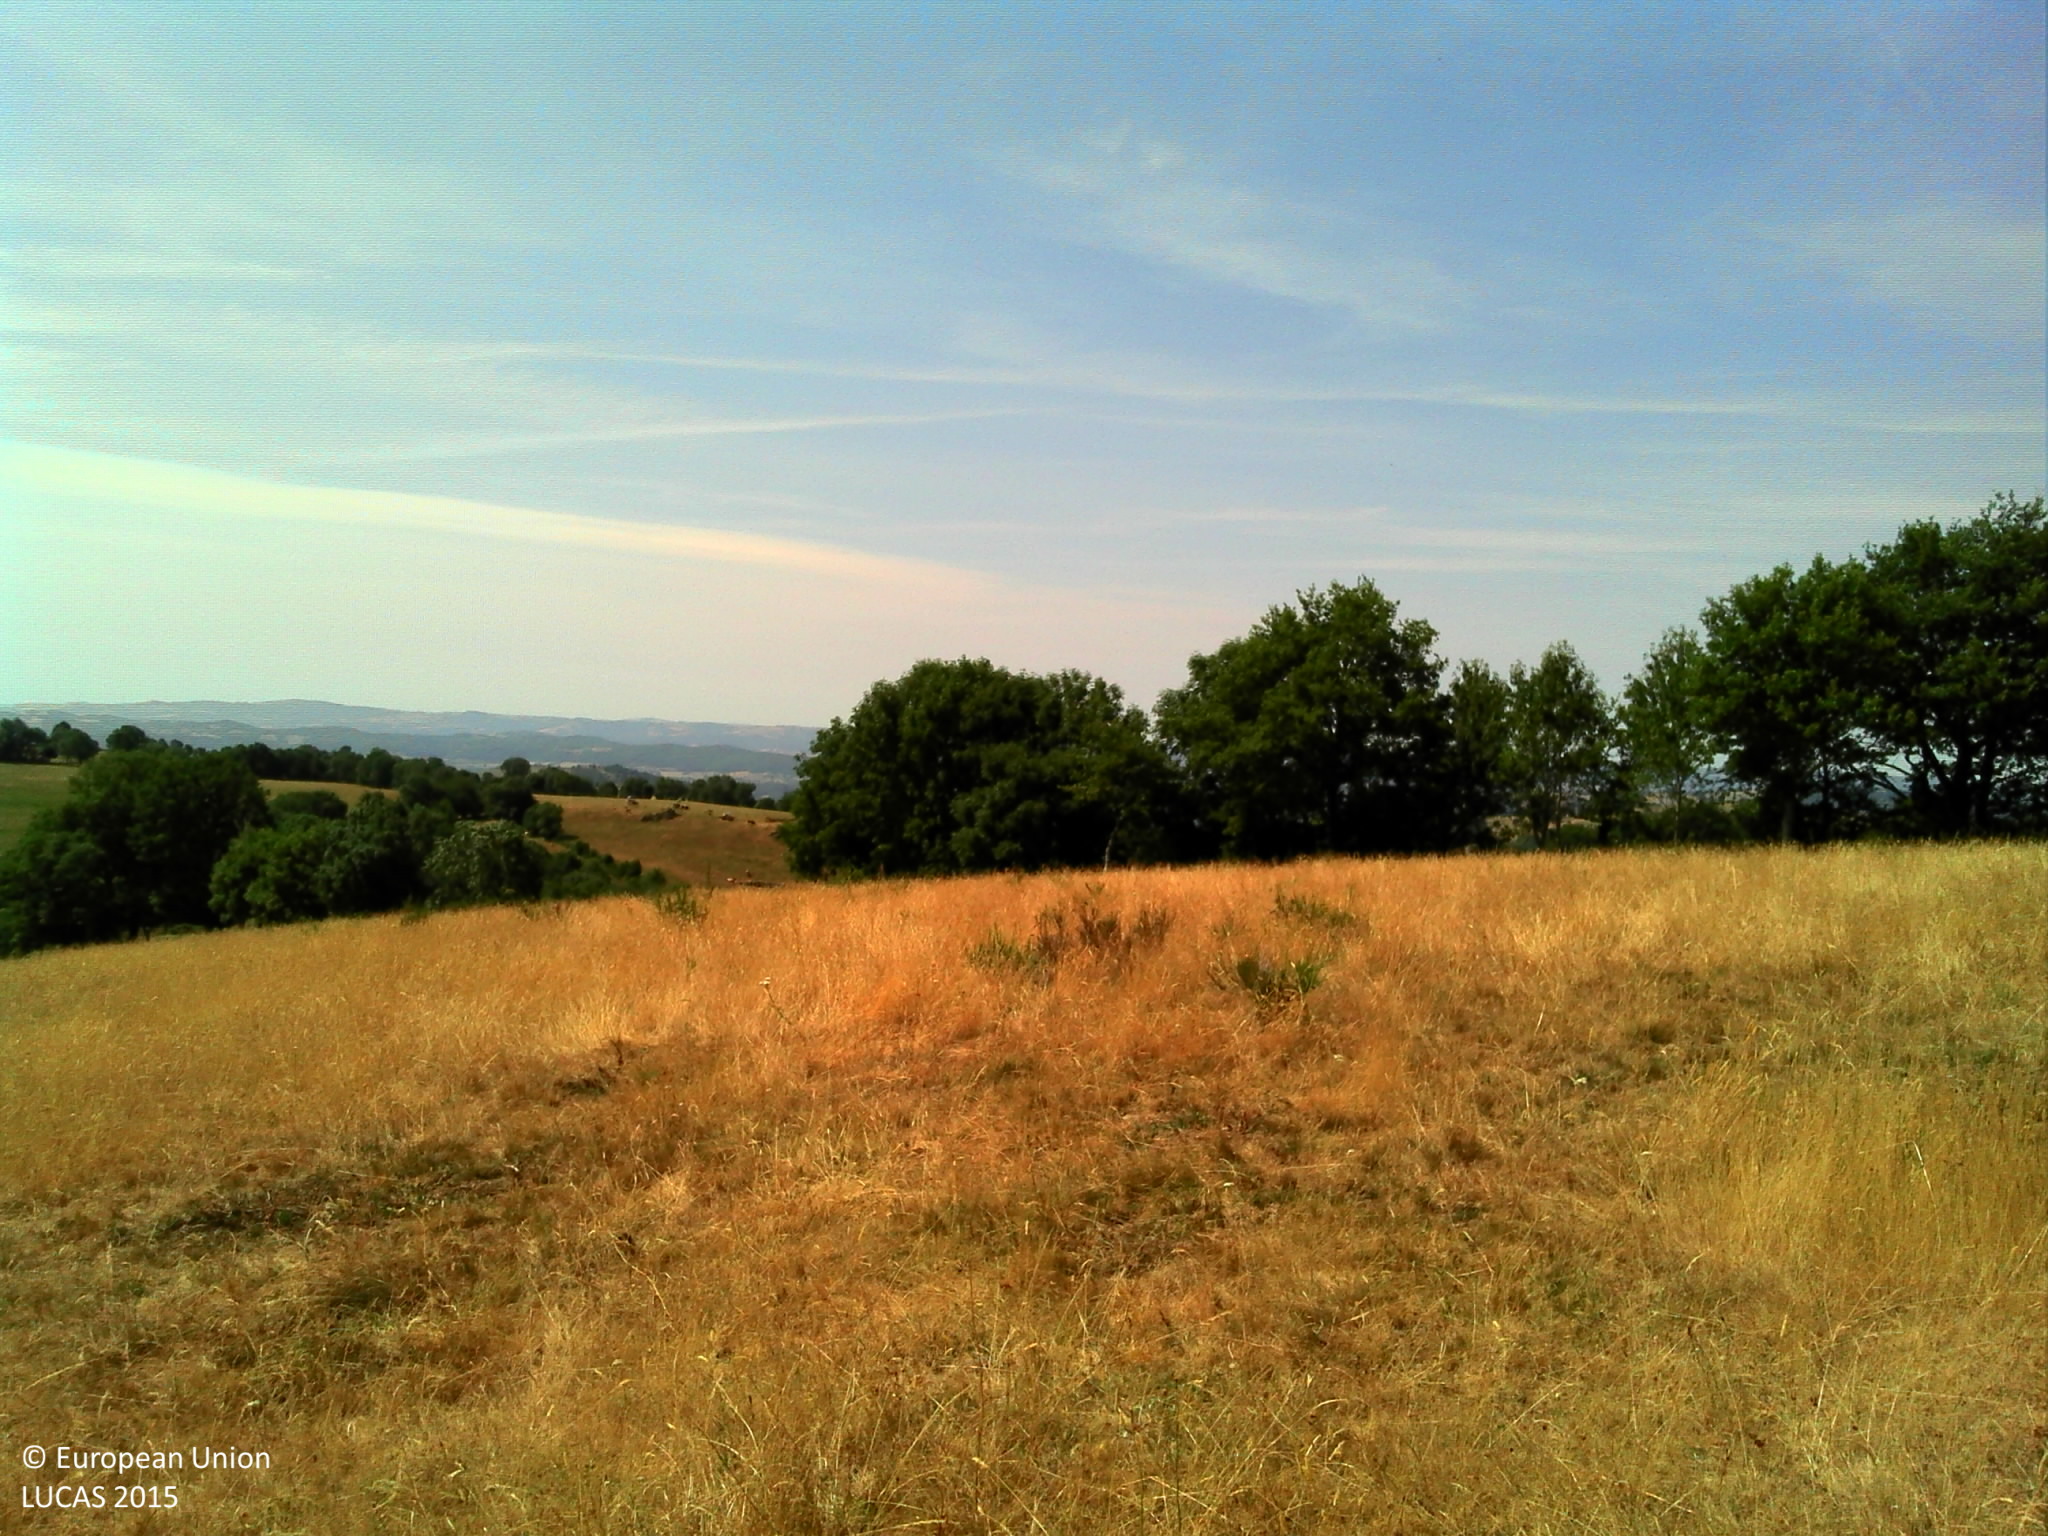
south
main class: Grassland
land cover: Grassland without tree/shrub cover
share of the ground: > 75 %
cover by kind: herbaceous plants 100 %
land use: Agriculture (excluding fallow land and kitchen gardens)
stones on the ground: 10 - 25 %
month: July
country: FR
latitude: 44.5462
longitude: 2.9677
